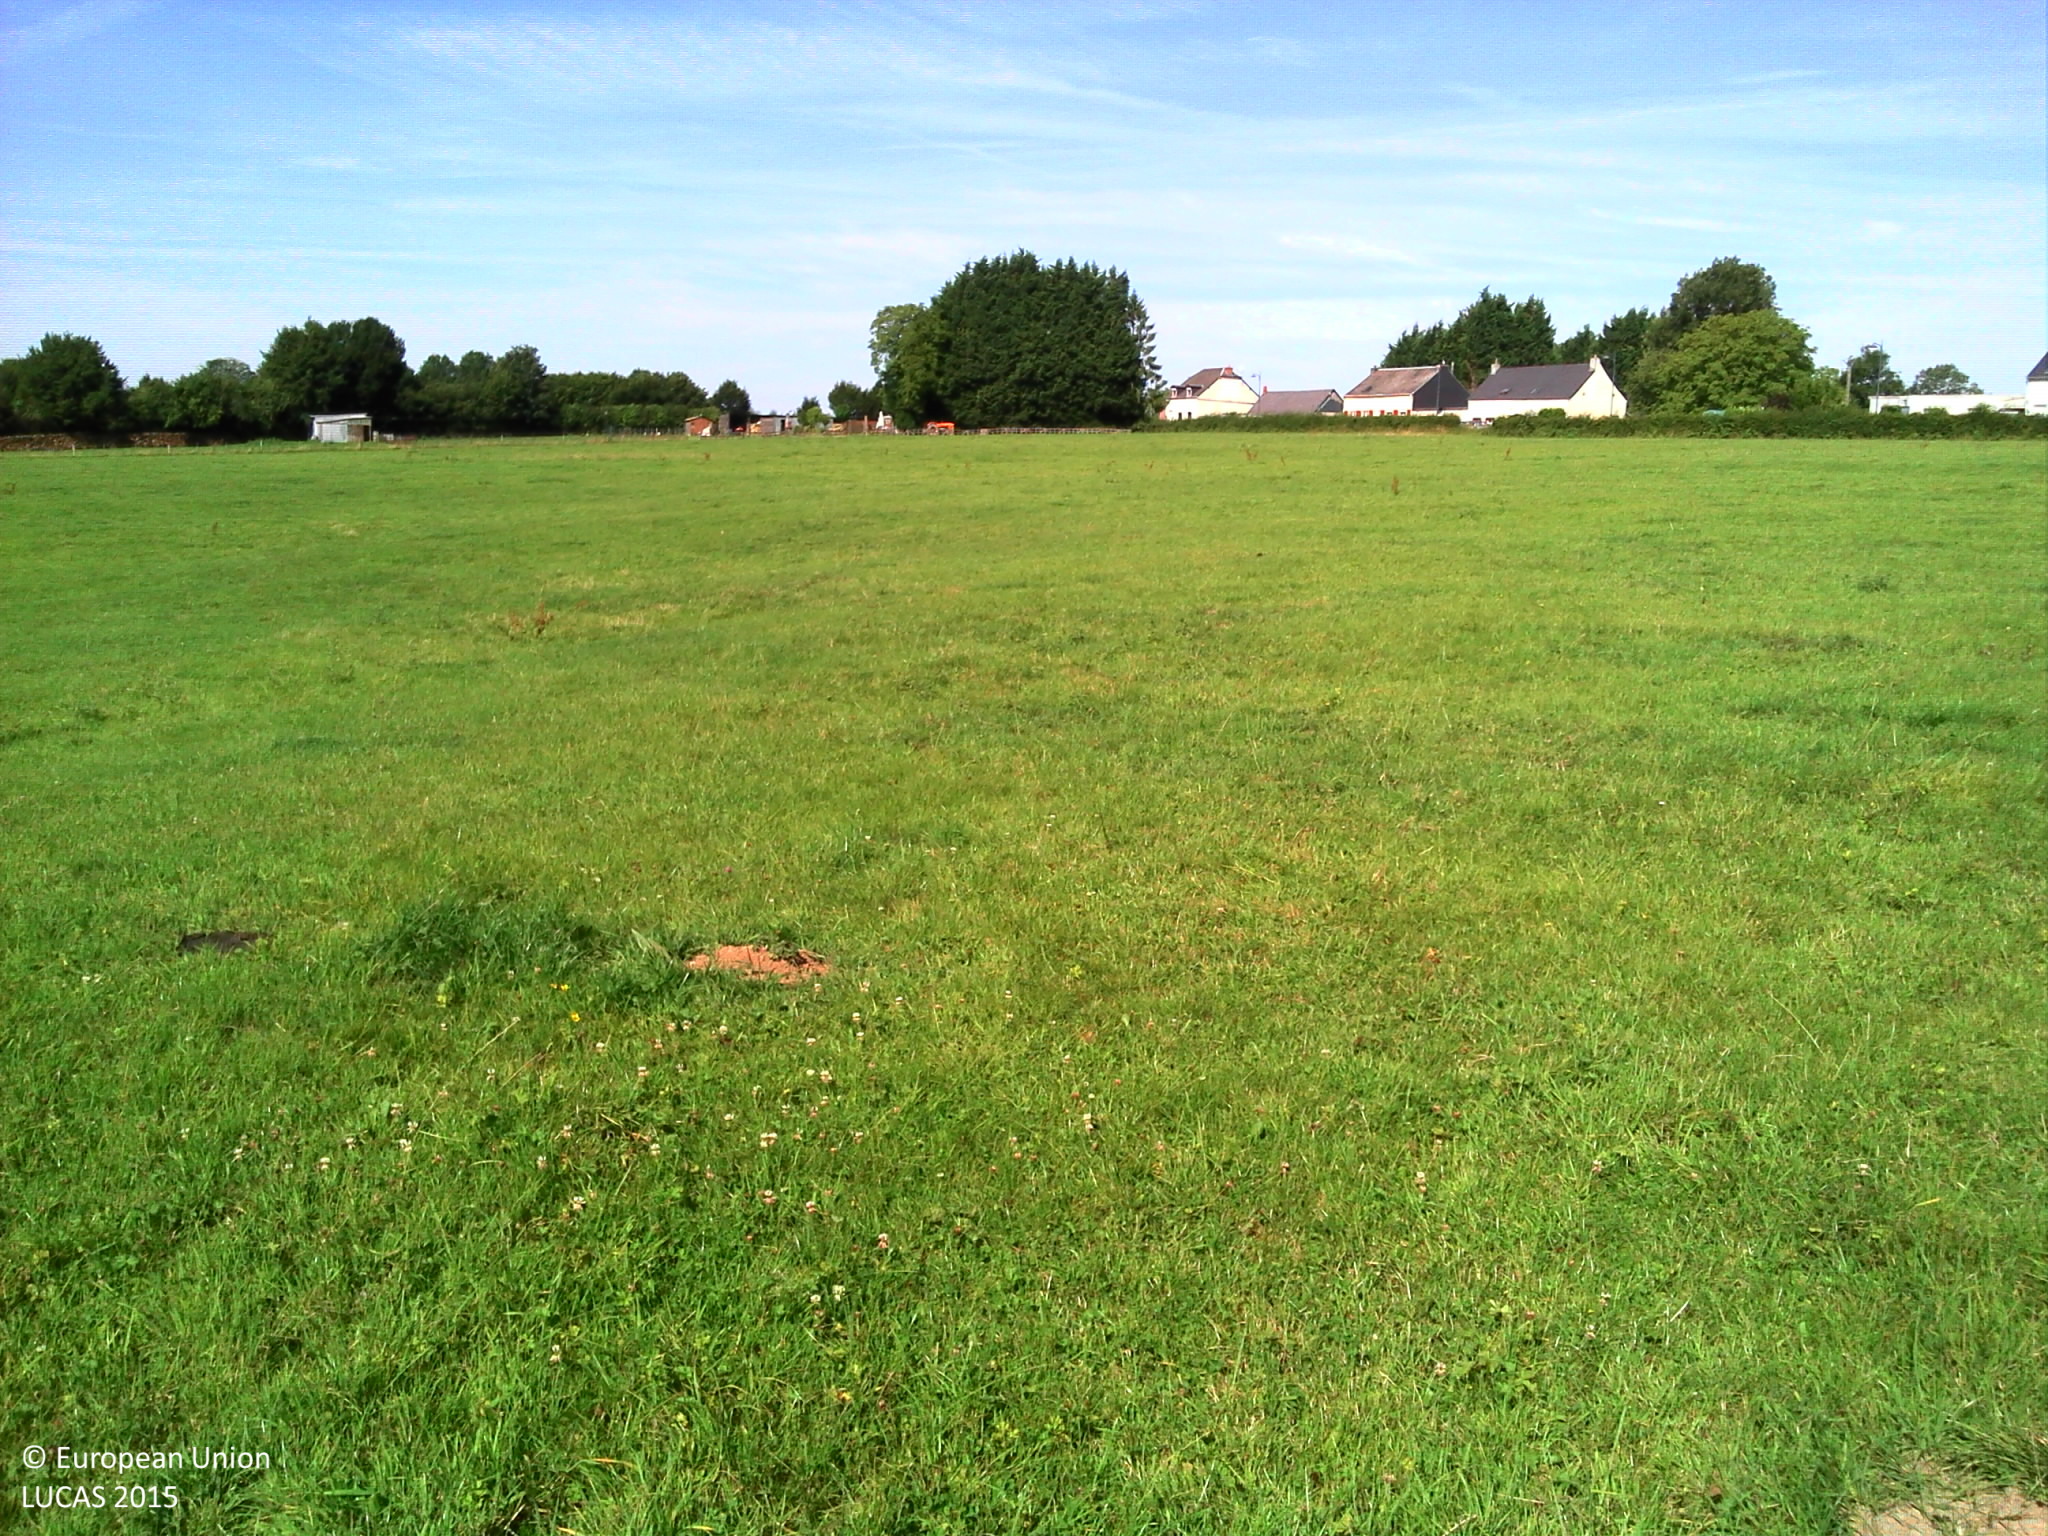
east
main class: Grassland
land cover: Grassland without tree/shrub cover
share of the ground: > 75 %
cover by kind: herbaceous plants 95 %, lichens and mosses 5 %
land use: Agriculture (excluding fallow land and kitchen gardens)
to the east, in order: Grassland without tree/shrub cover; Grassland with sparse tree/shrub cover; Grassland without tree/shrub cover; Fences; Grass margins; Tracks; Grass margins; Fences; Grassland without tree/shrub cover; Spontaneously vegetated surfaces; Abandoned hedges; Grassland without tree/shrub cover
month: August
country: FR
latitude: 50.0818
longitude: 4.0272
